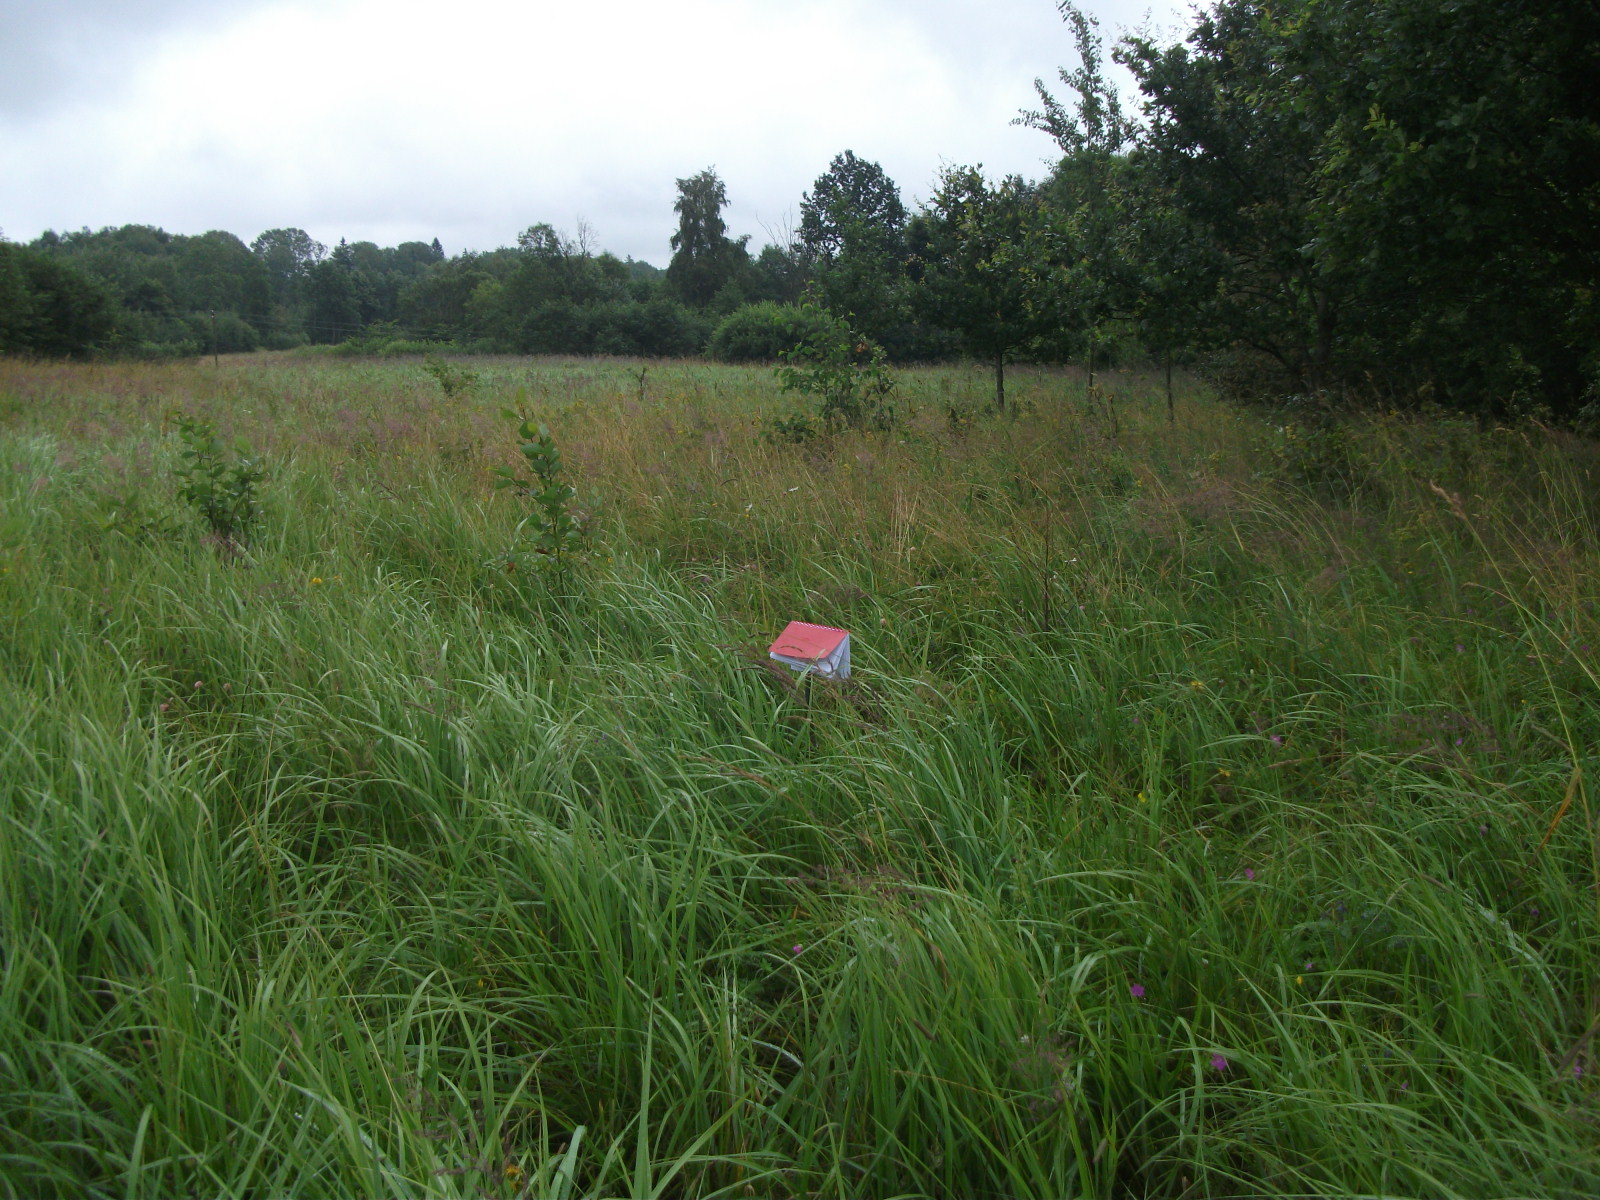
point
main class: Grassland
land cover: Grassland with sparse tree/shrub cover
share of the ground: > 75 %
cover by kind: herbaceous plants 90 %, broadleaved forest trees 5 %, shrubs 5 %
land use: Agriculture (excluding fallow land and kitchen gardens)
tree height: < 5 m
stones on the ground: < 10 %
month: July
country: LV
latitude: 56.7847
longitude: 25.7572
